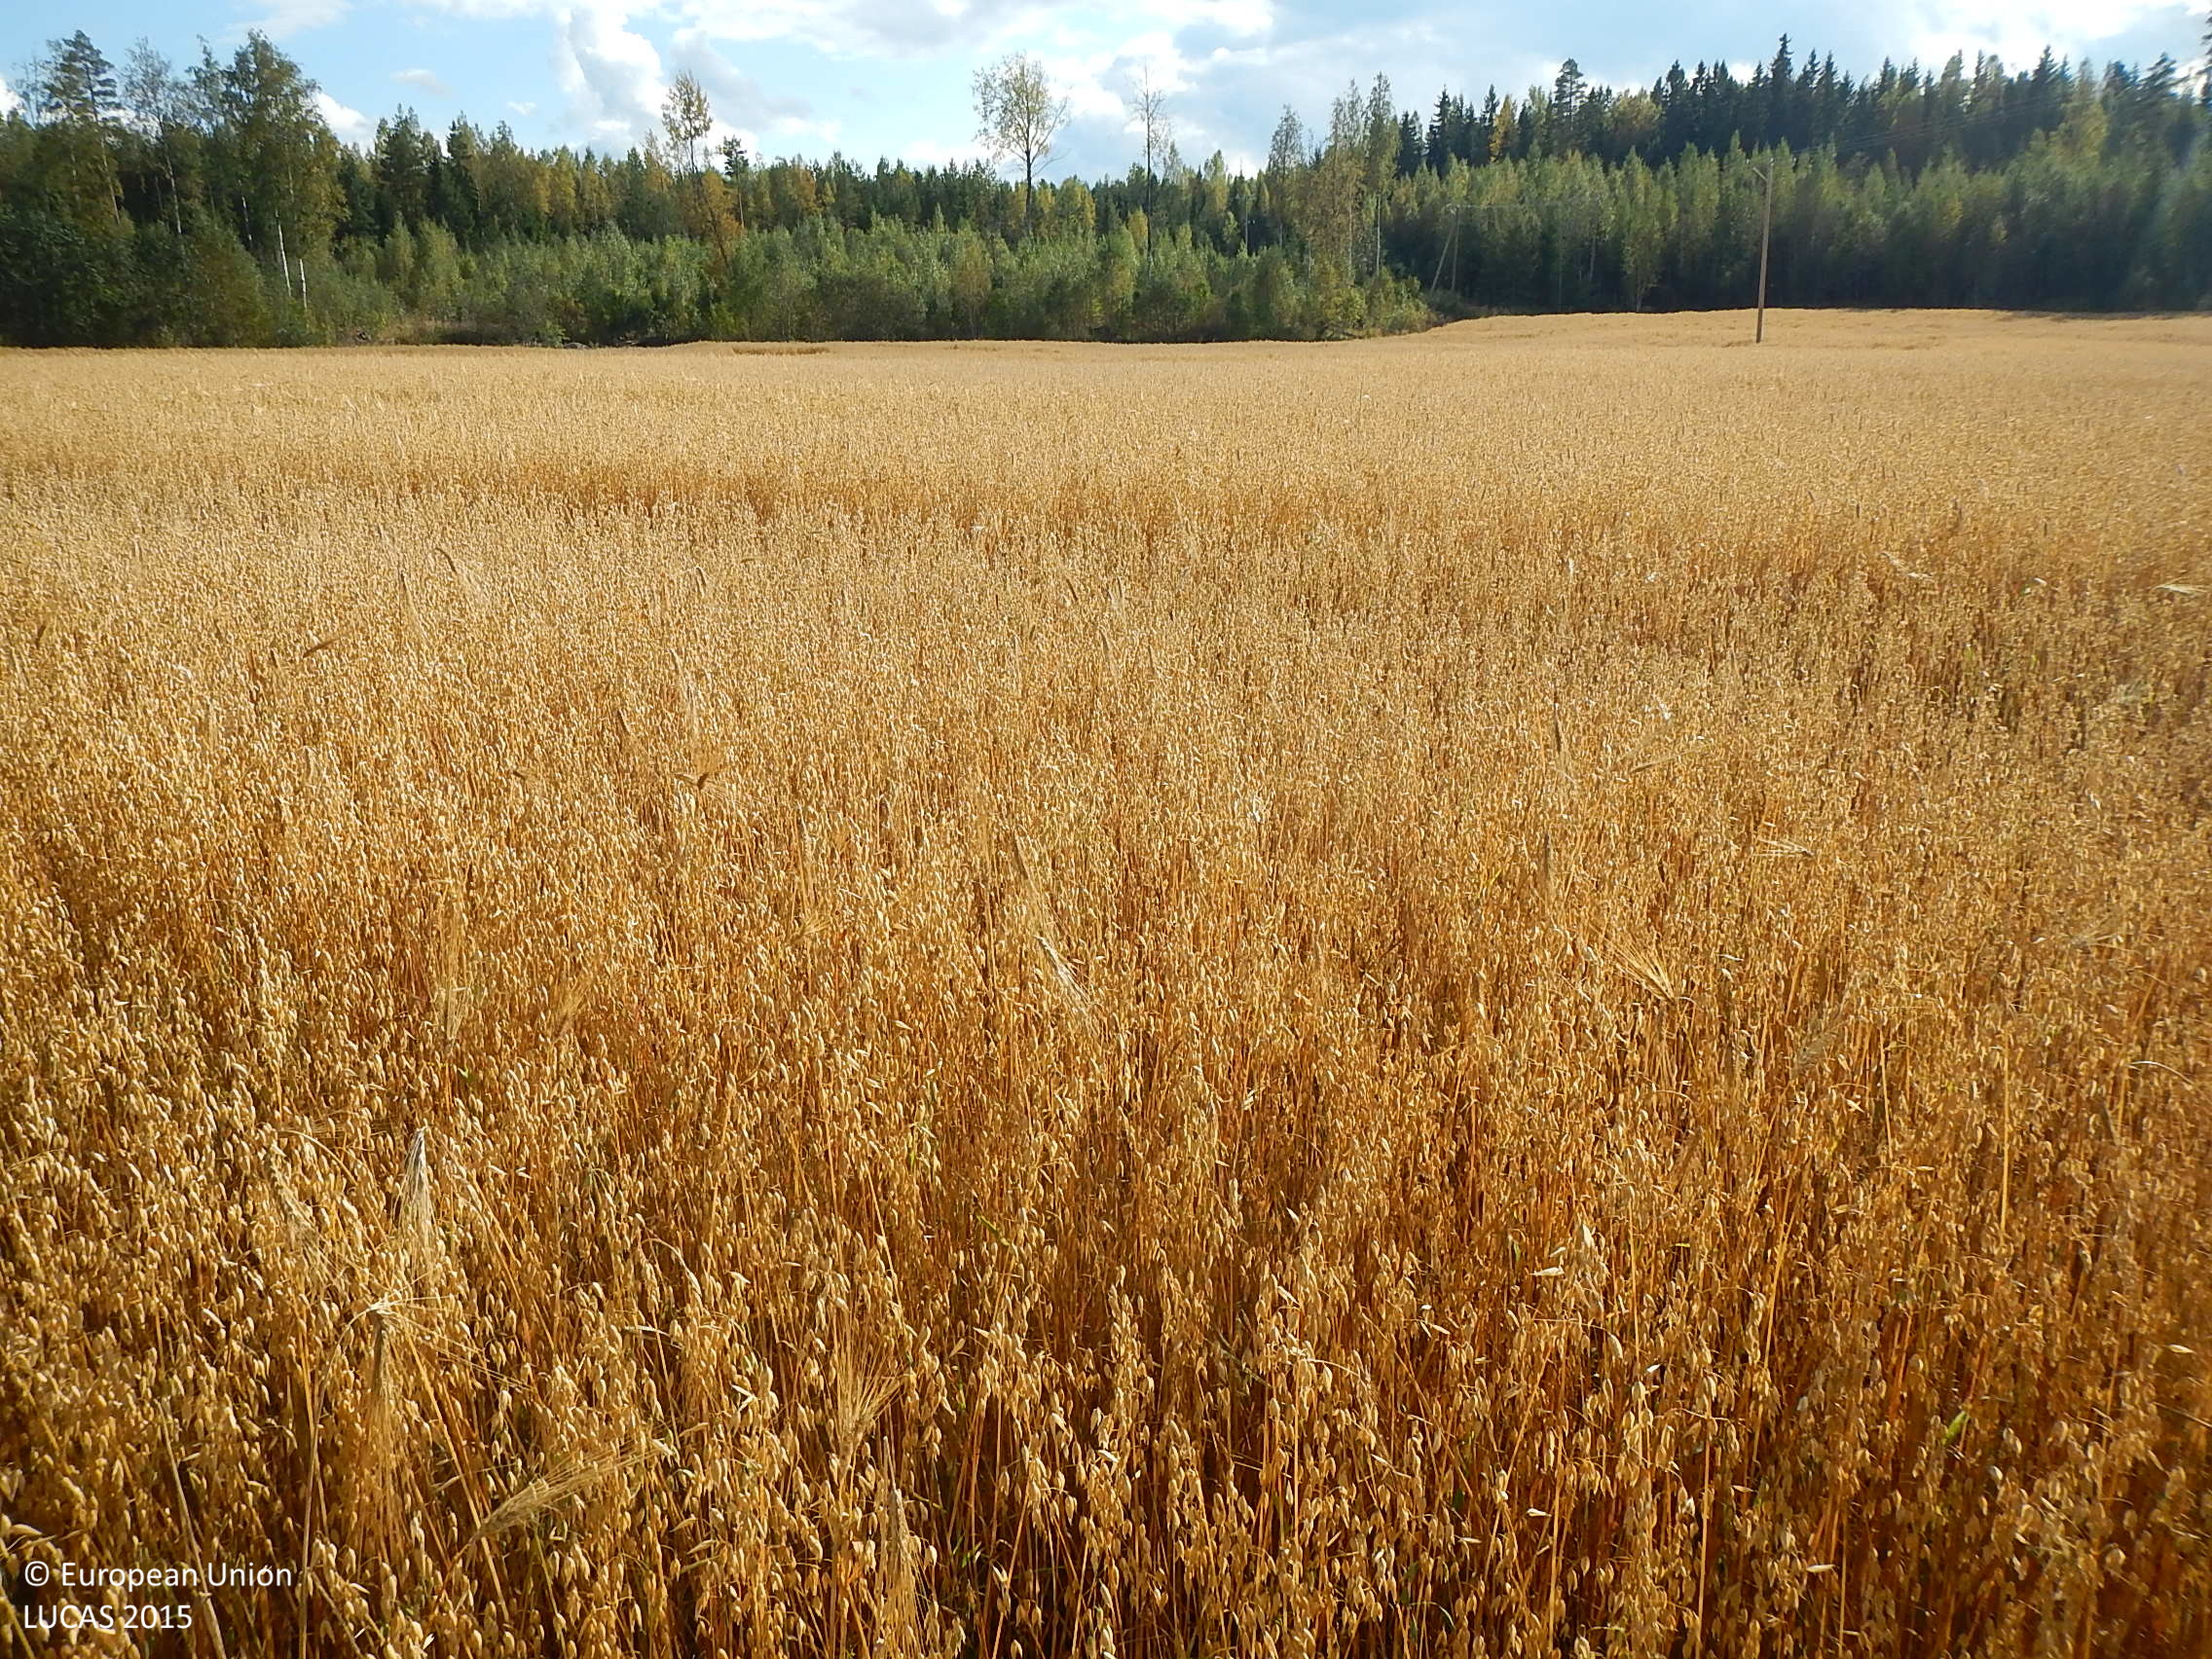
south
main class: Cropland
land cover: Oats
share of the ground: > 75 %
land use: Agriculture (excluding fallow land and kitchen gardens)
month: September
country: FI
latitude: 61.5387
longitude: 22.3058
